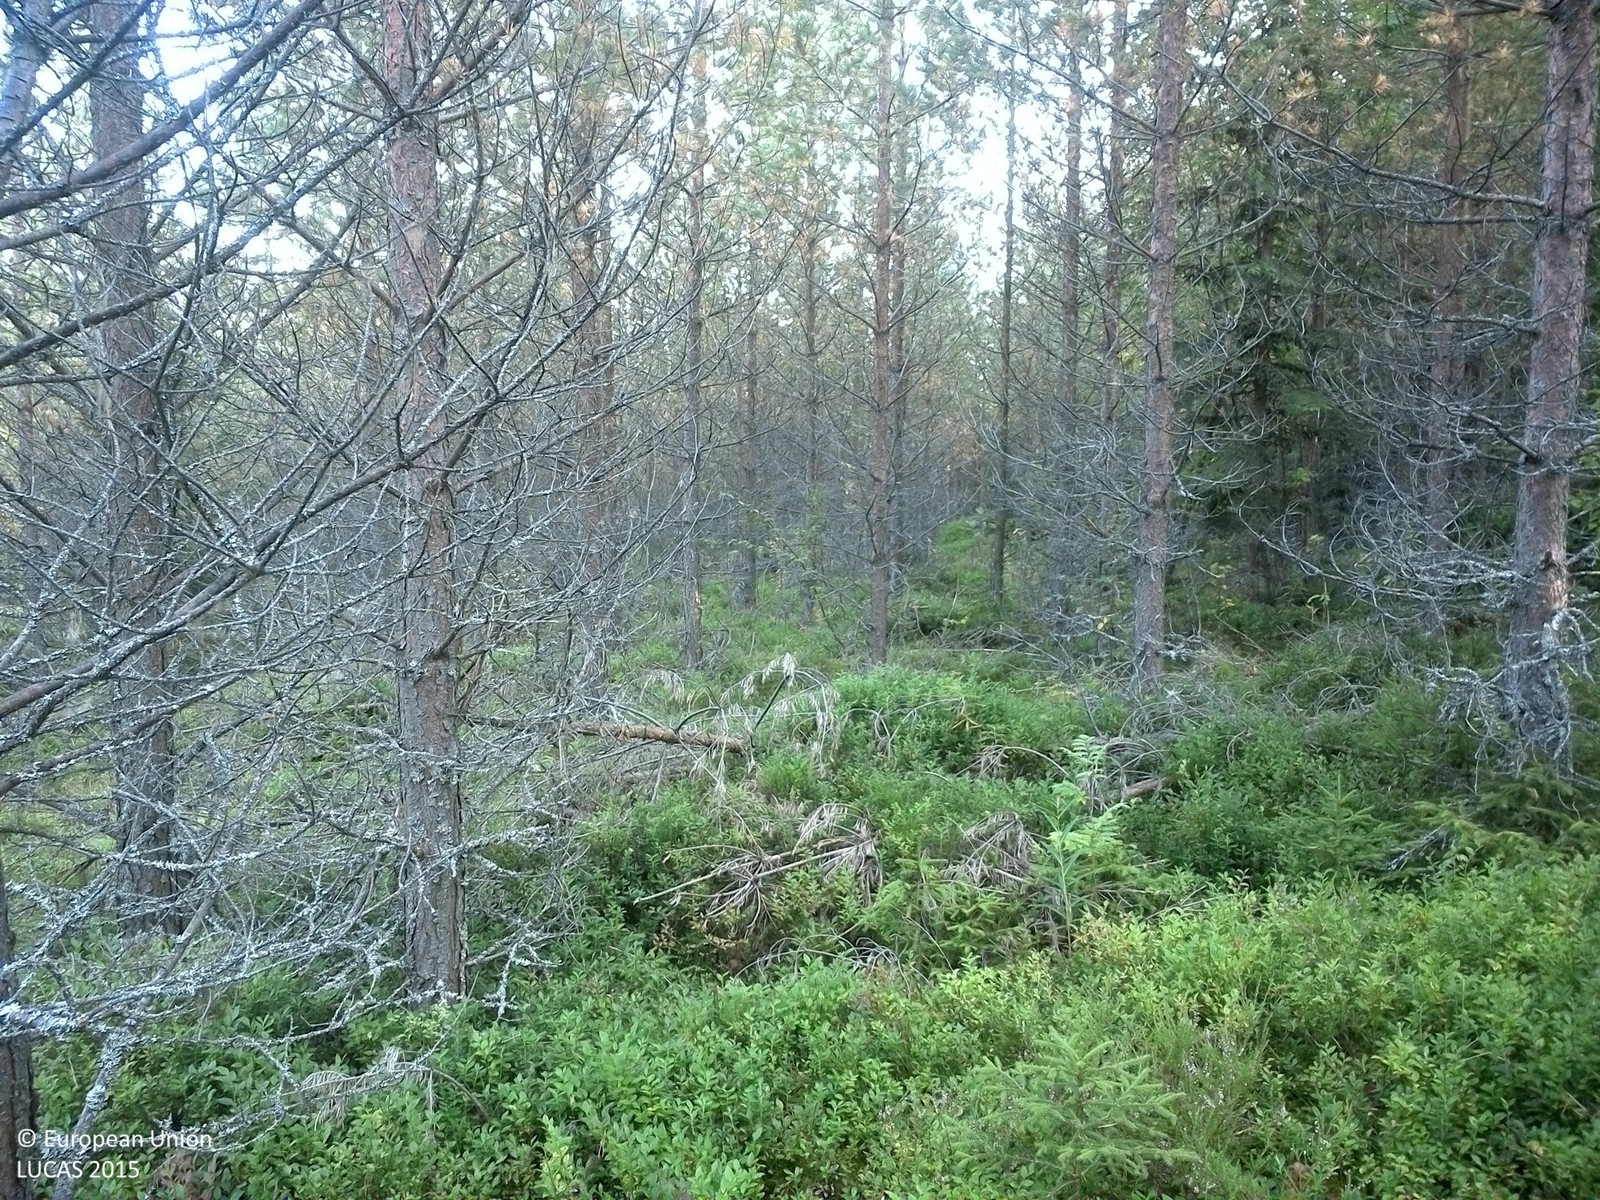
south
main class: Woodland
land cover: Pine dominated coniferous woodland
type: boreal forest
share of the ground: > 75 %
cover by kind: coniferous forest trees 75 %, shrubs 20 %, lichens and mosses 5 %
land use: Forestry
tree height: > 5 m
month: September
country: SE
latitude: 61.7433
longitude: 15.2660
